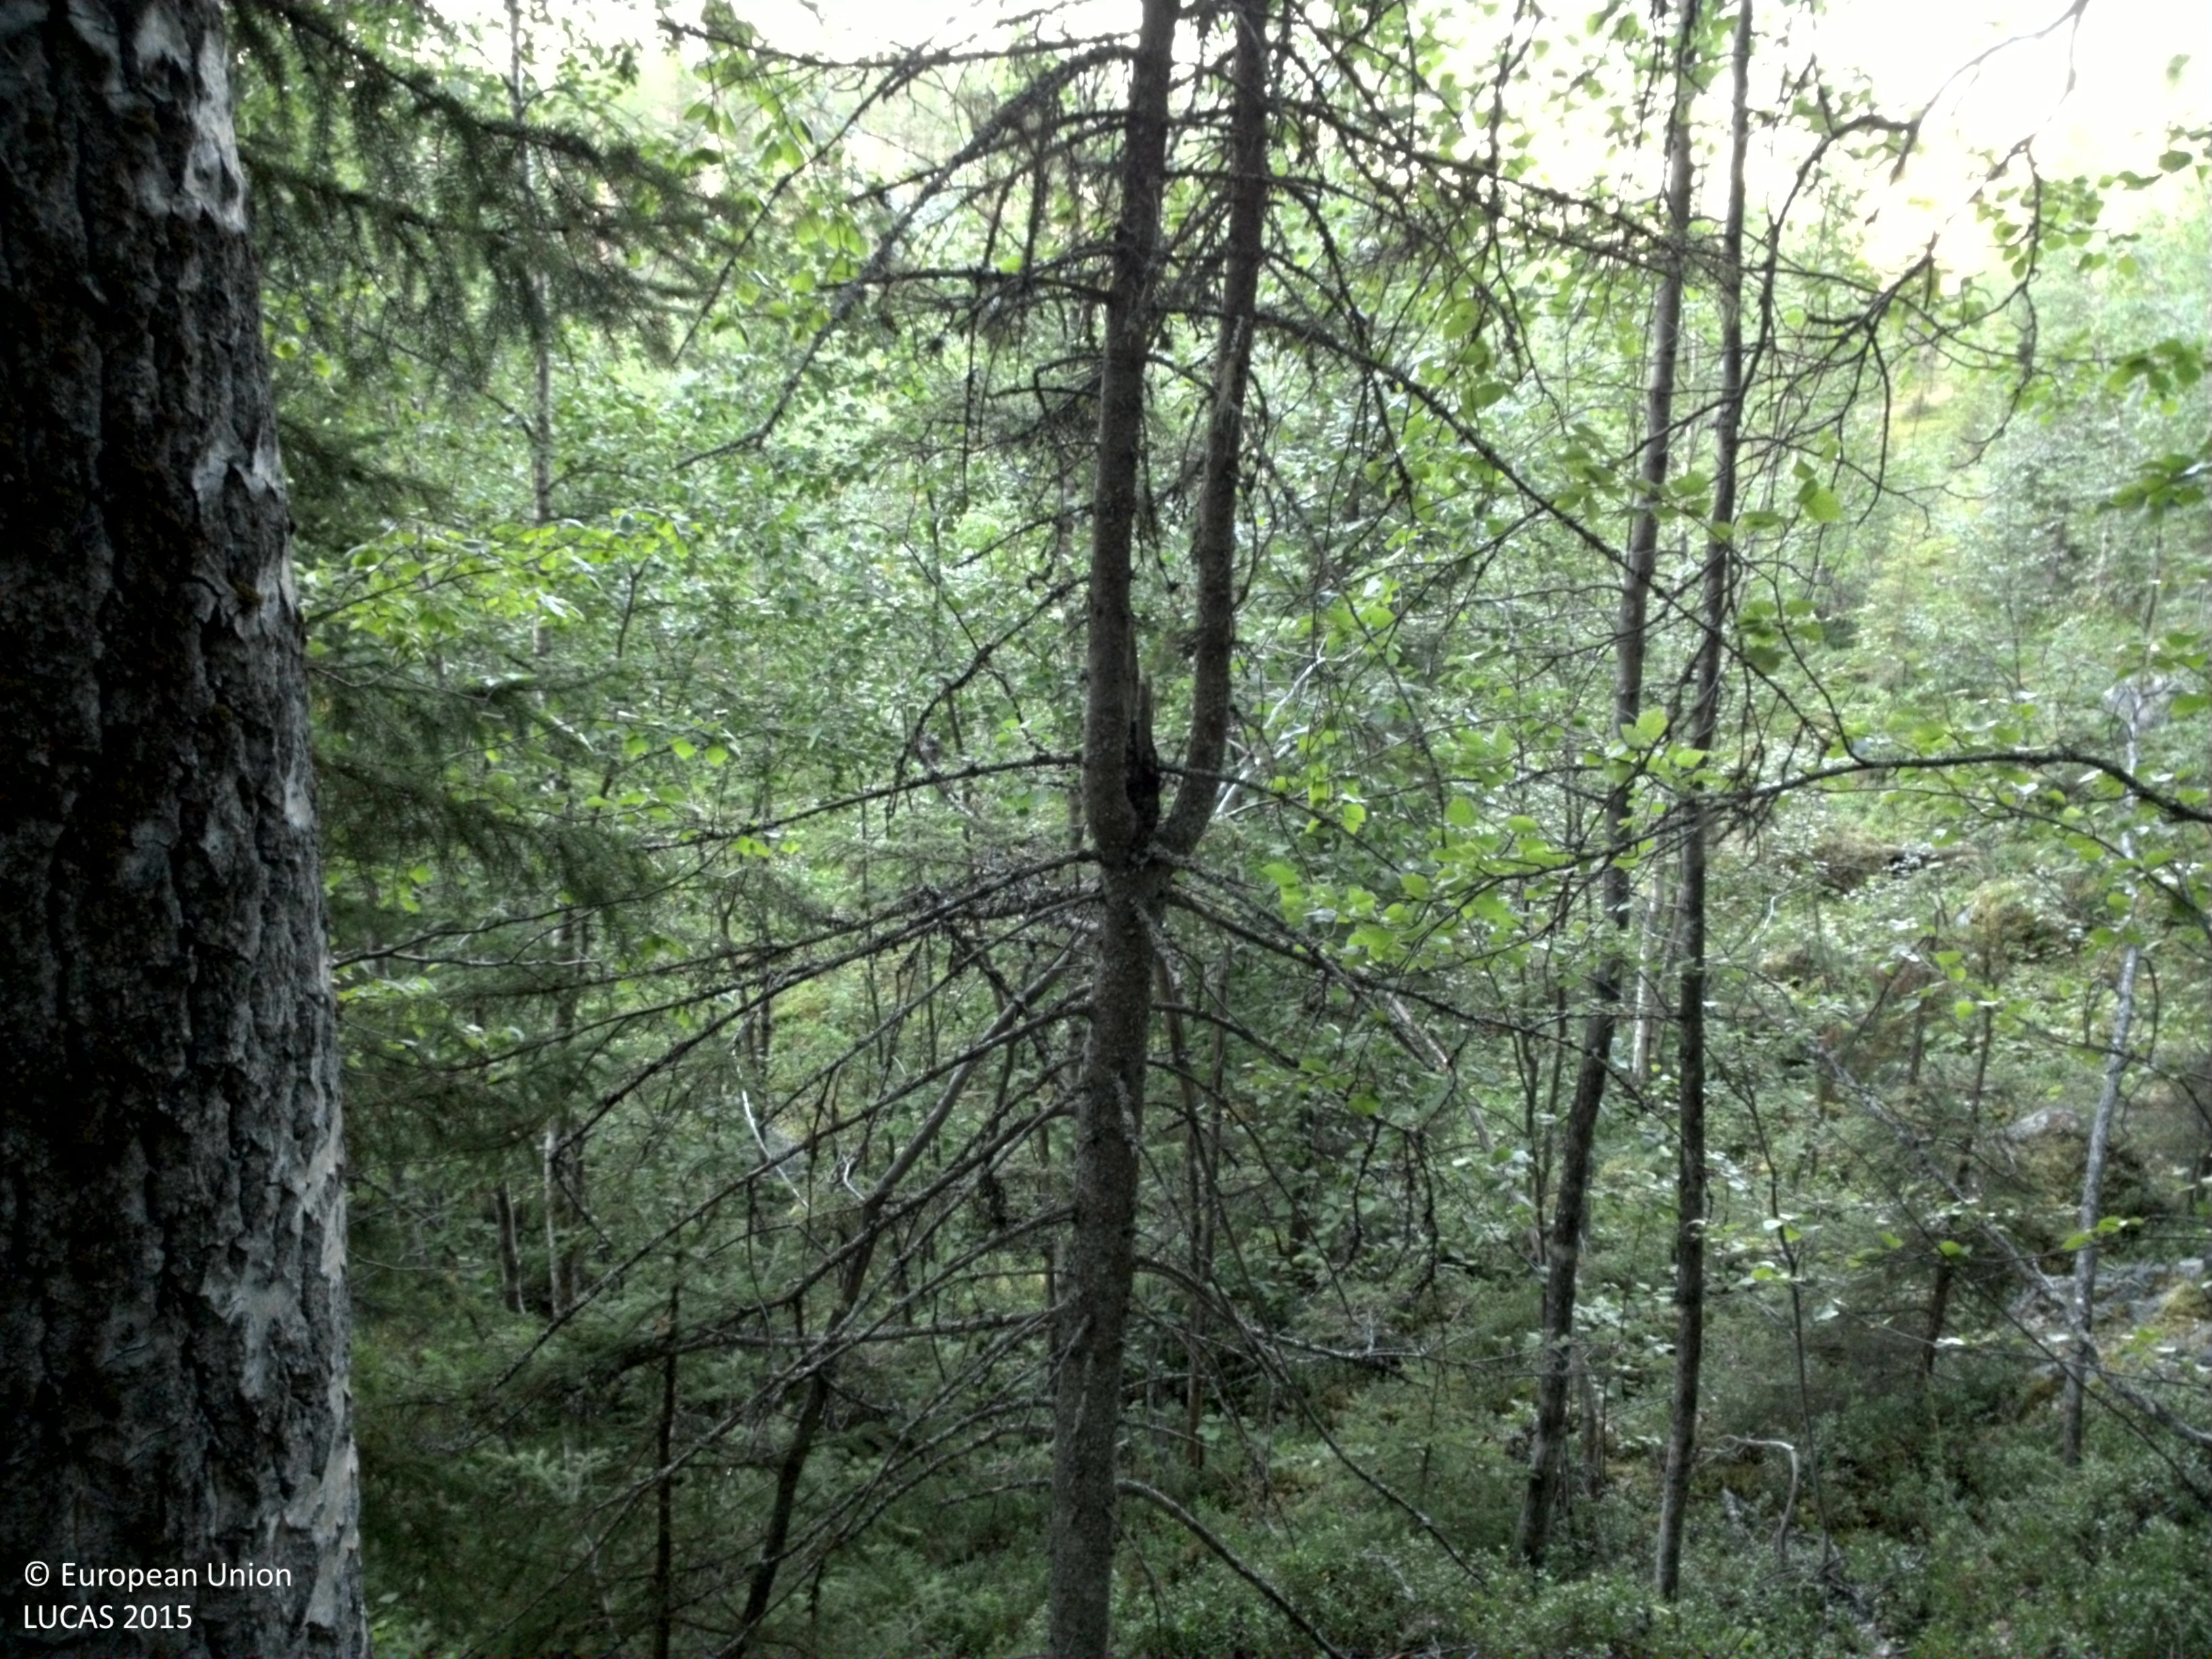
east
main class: Woodland
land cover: Broadleaved woodland
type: hemiboreal forest and nemoral coniferous forest and mixed broadleaved-coniferous forest
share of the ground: 25 - 50 %
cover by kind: shrubs 50 %, broadleaved forest trees 40 %, coniferous forest trees 5 %, consolidated bare surface 5 %
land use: Amenities, museums, leisure
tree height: < 5 m
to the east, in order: Broadleaved woodland; Spruce dominated mixed woodland; Tracks; Pine dominated coniferous woodland; Shrubland with sparse tree cover; Pine dominated coniferous woodland
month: August
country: SE
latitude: 66.3384
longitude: 20.6995
